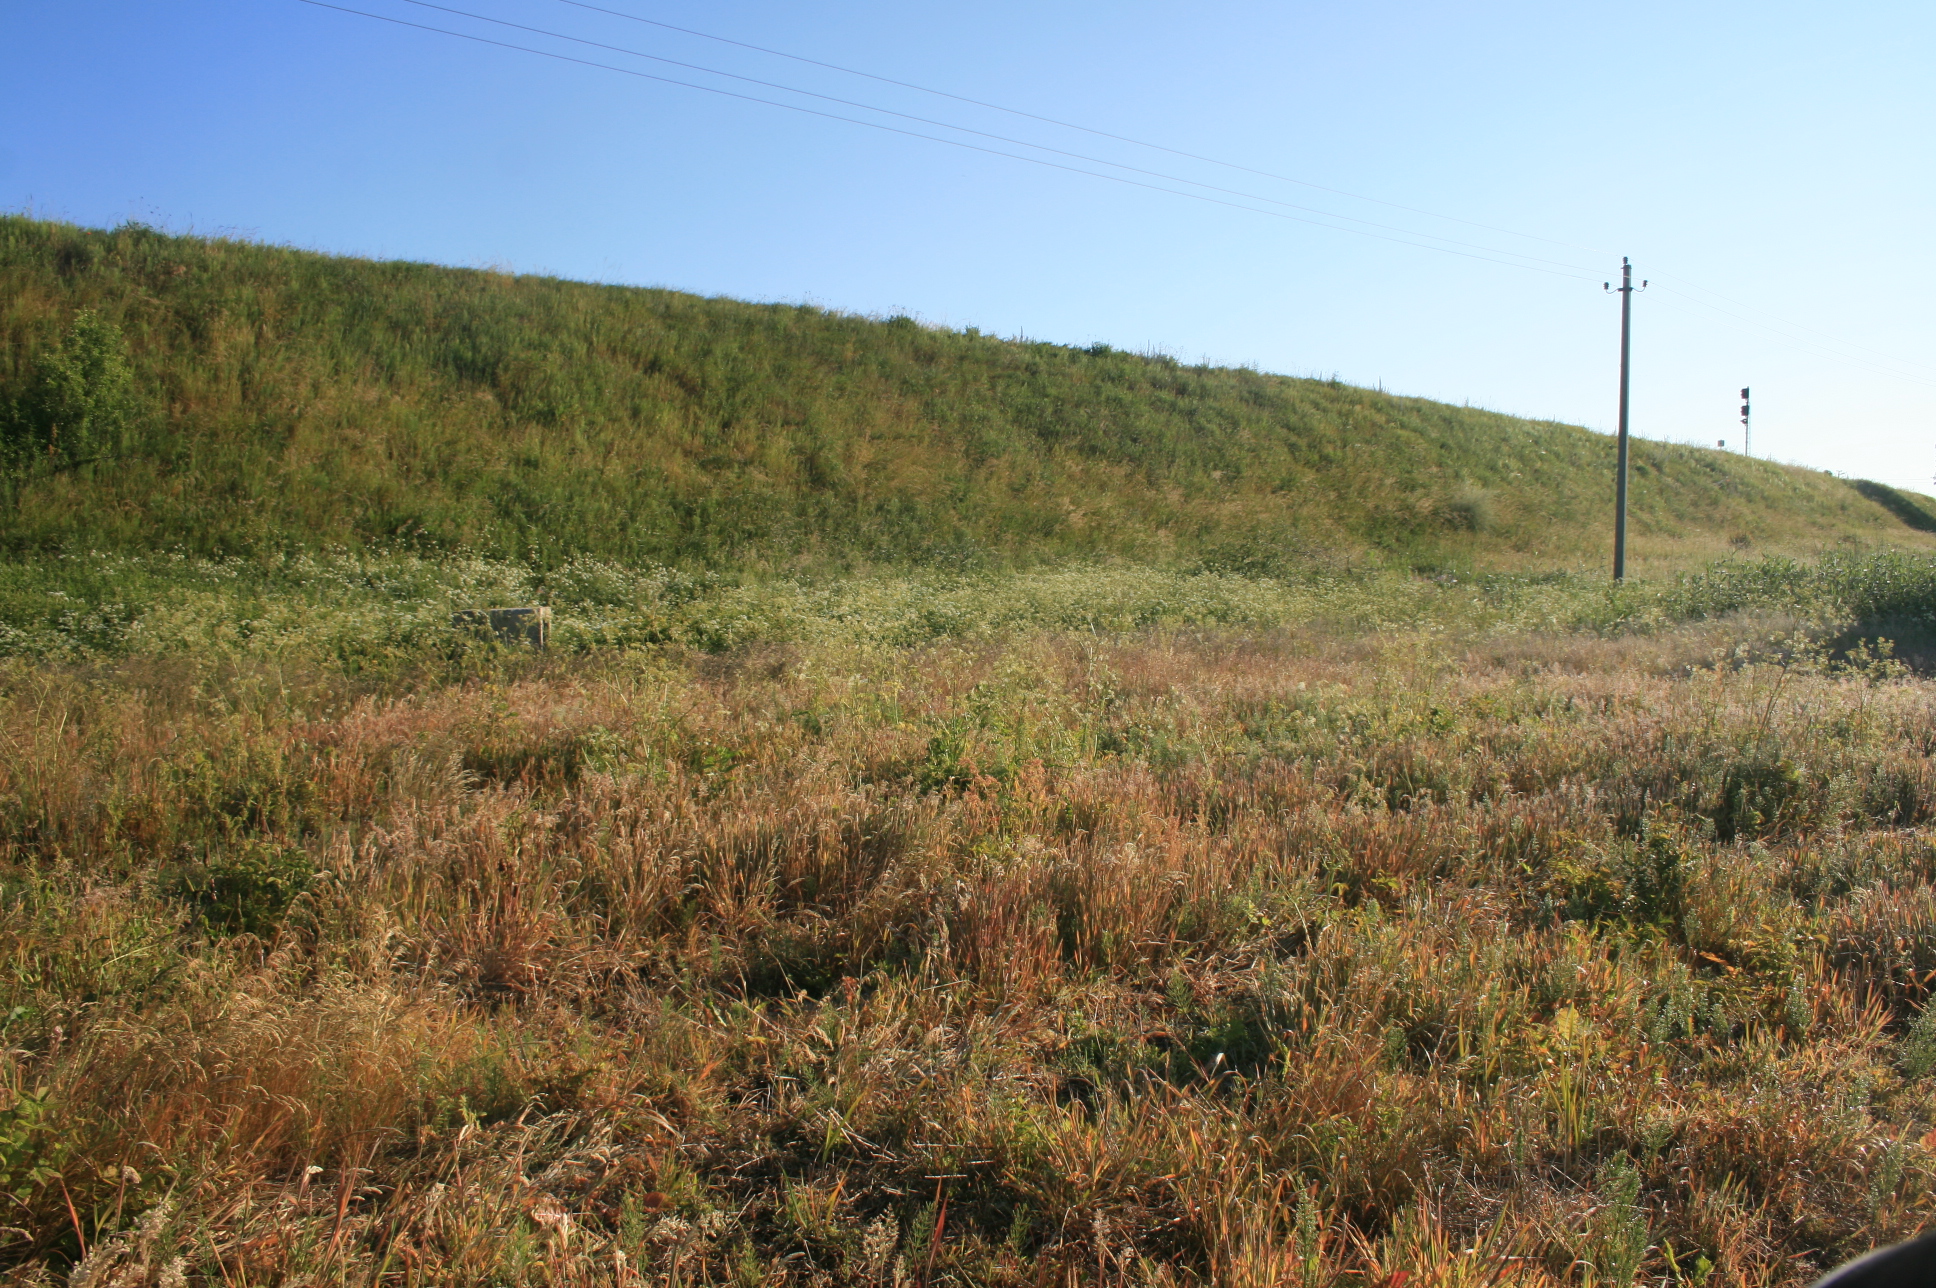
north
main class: Grassland
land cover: Spontaneously vegetated surfaces
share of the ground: > 75 %
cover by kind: herbaceous plants 100 %
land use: Fallow land
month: June
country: LT
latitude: 55.2315
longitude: 22.2755
